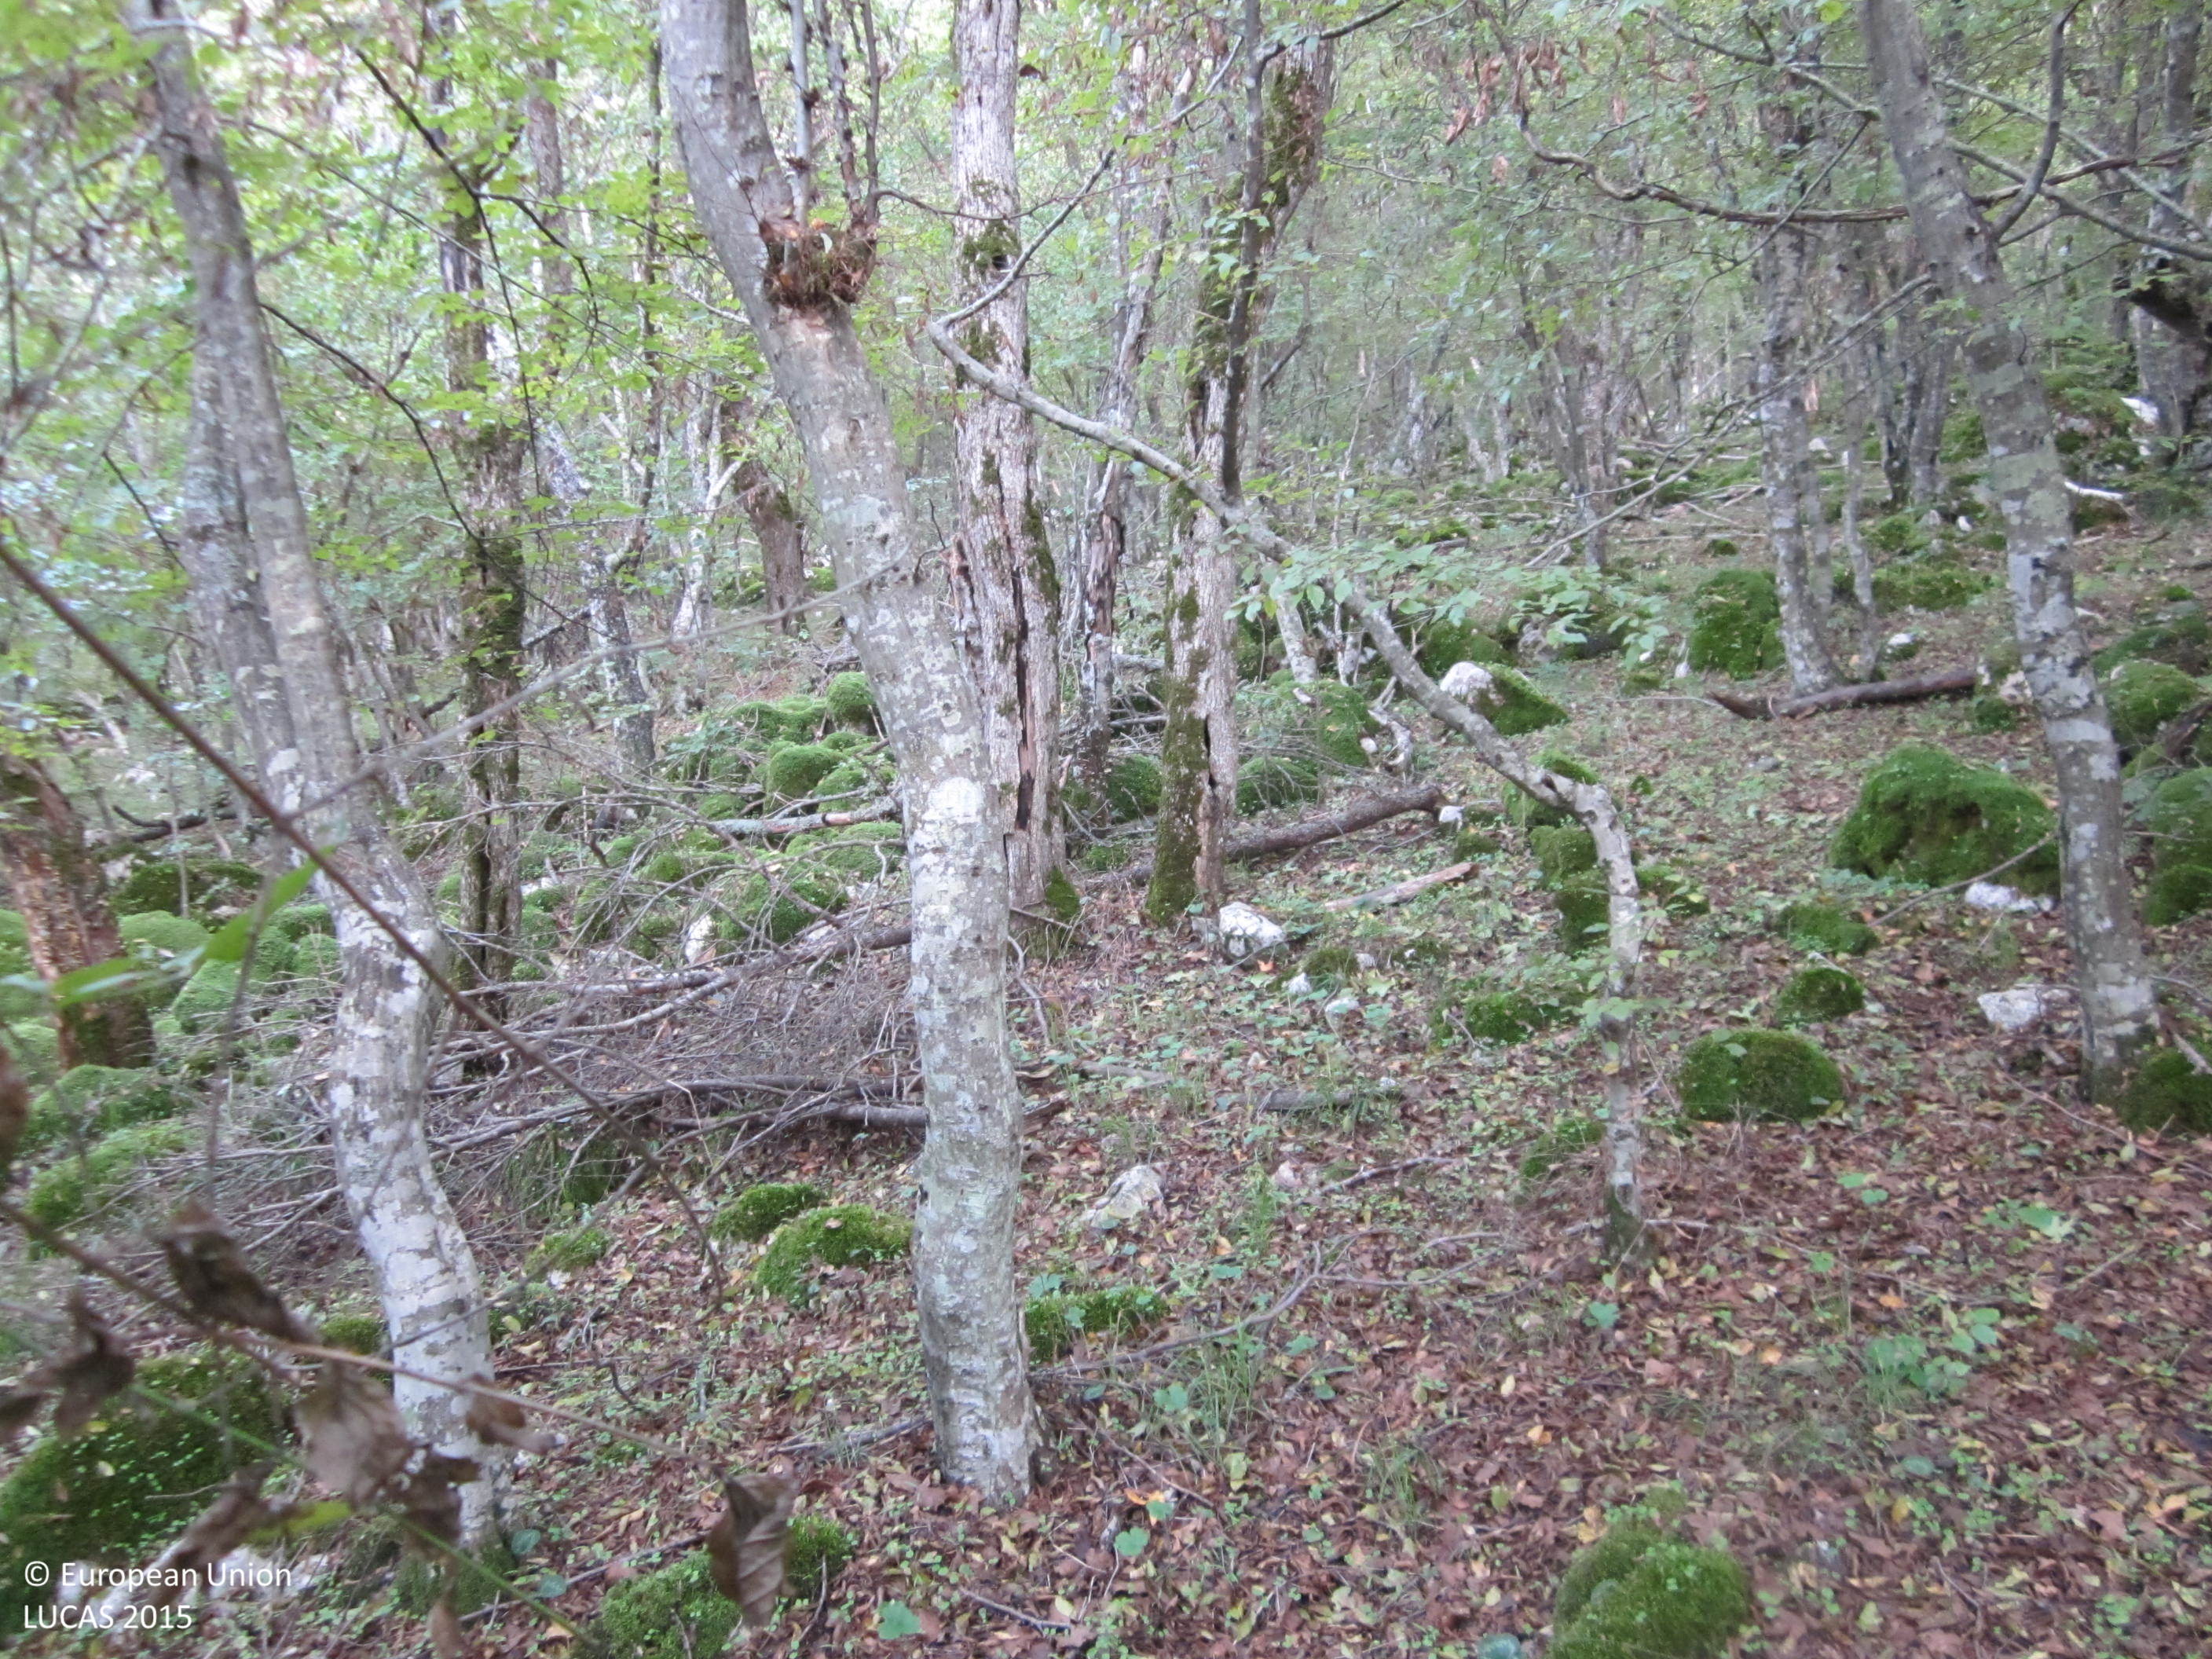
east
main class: Woodland
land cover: Broadleaved woodland
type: mesophytic deciduous forest
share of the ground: > 75 %
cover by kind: broadleaved forest trees 90 %, lichens and mosses 5 %, unconsolidated bare surface 5 %
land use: Forestry
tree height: > 5 m
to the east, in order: Broadleaved woodland
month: October
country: BG
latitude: 42.2116
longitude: 27.2469
